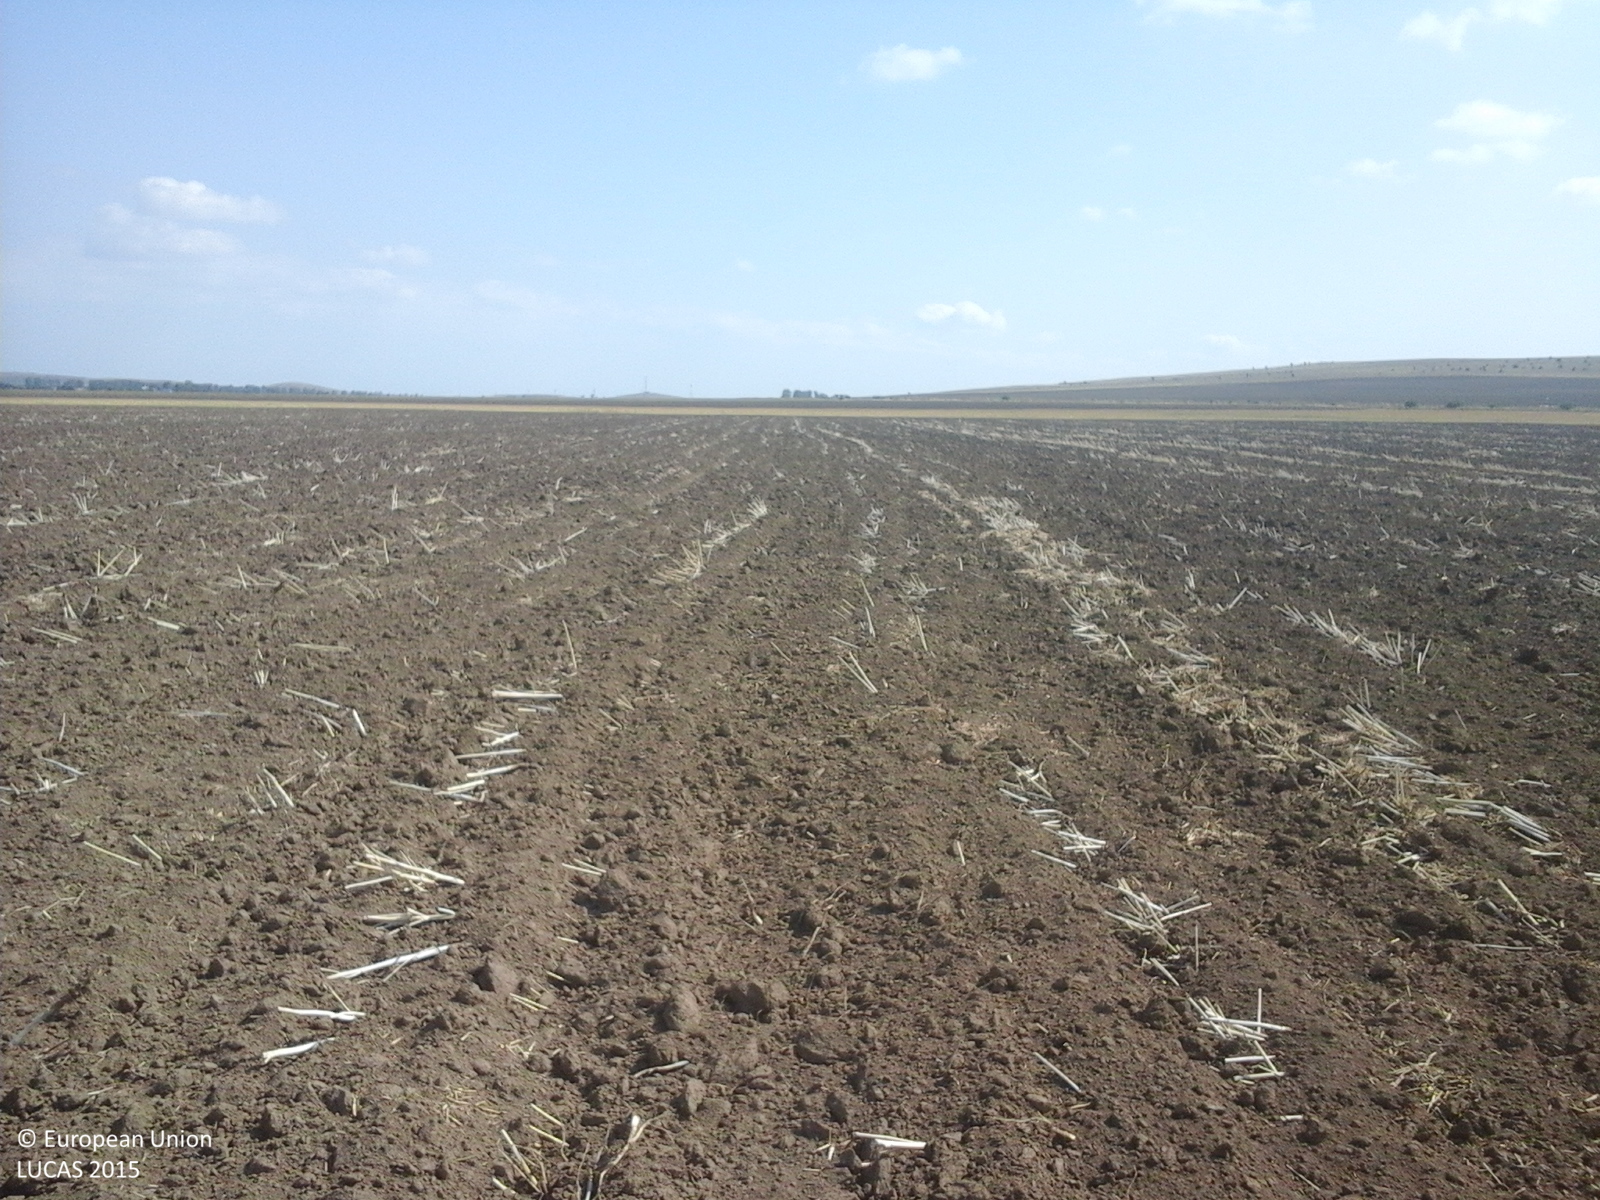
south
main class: Cropland
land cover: Rape and turnip rape
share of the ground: < 10 %
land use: Agriculture (excluding fallow land and kitchen gardens)
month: August
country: RO
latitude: 44.8182
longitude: 28.8680
